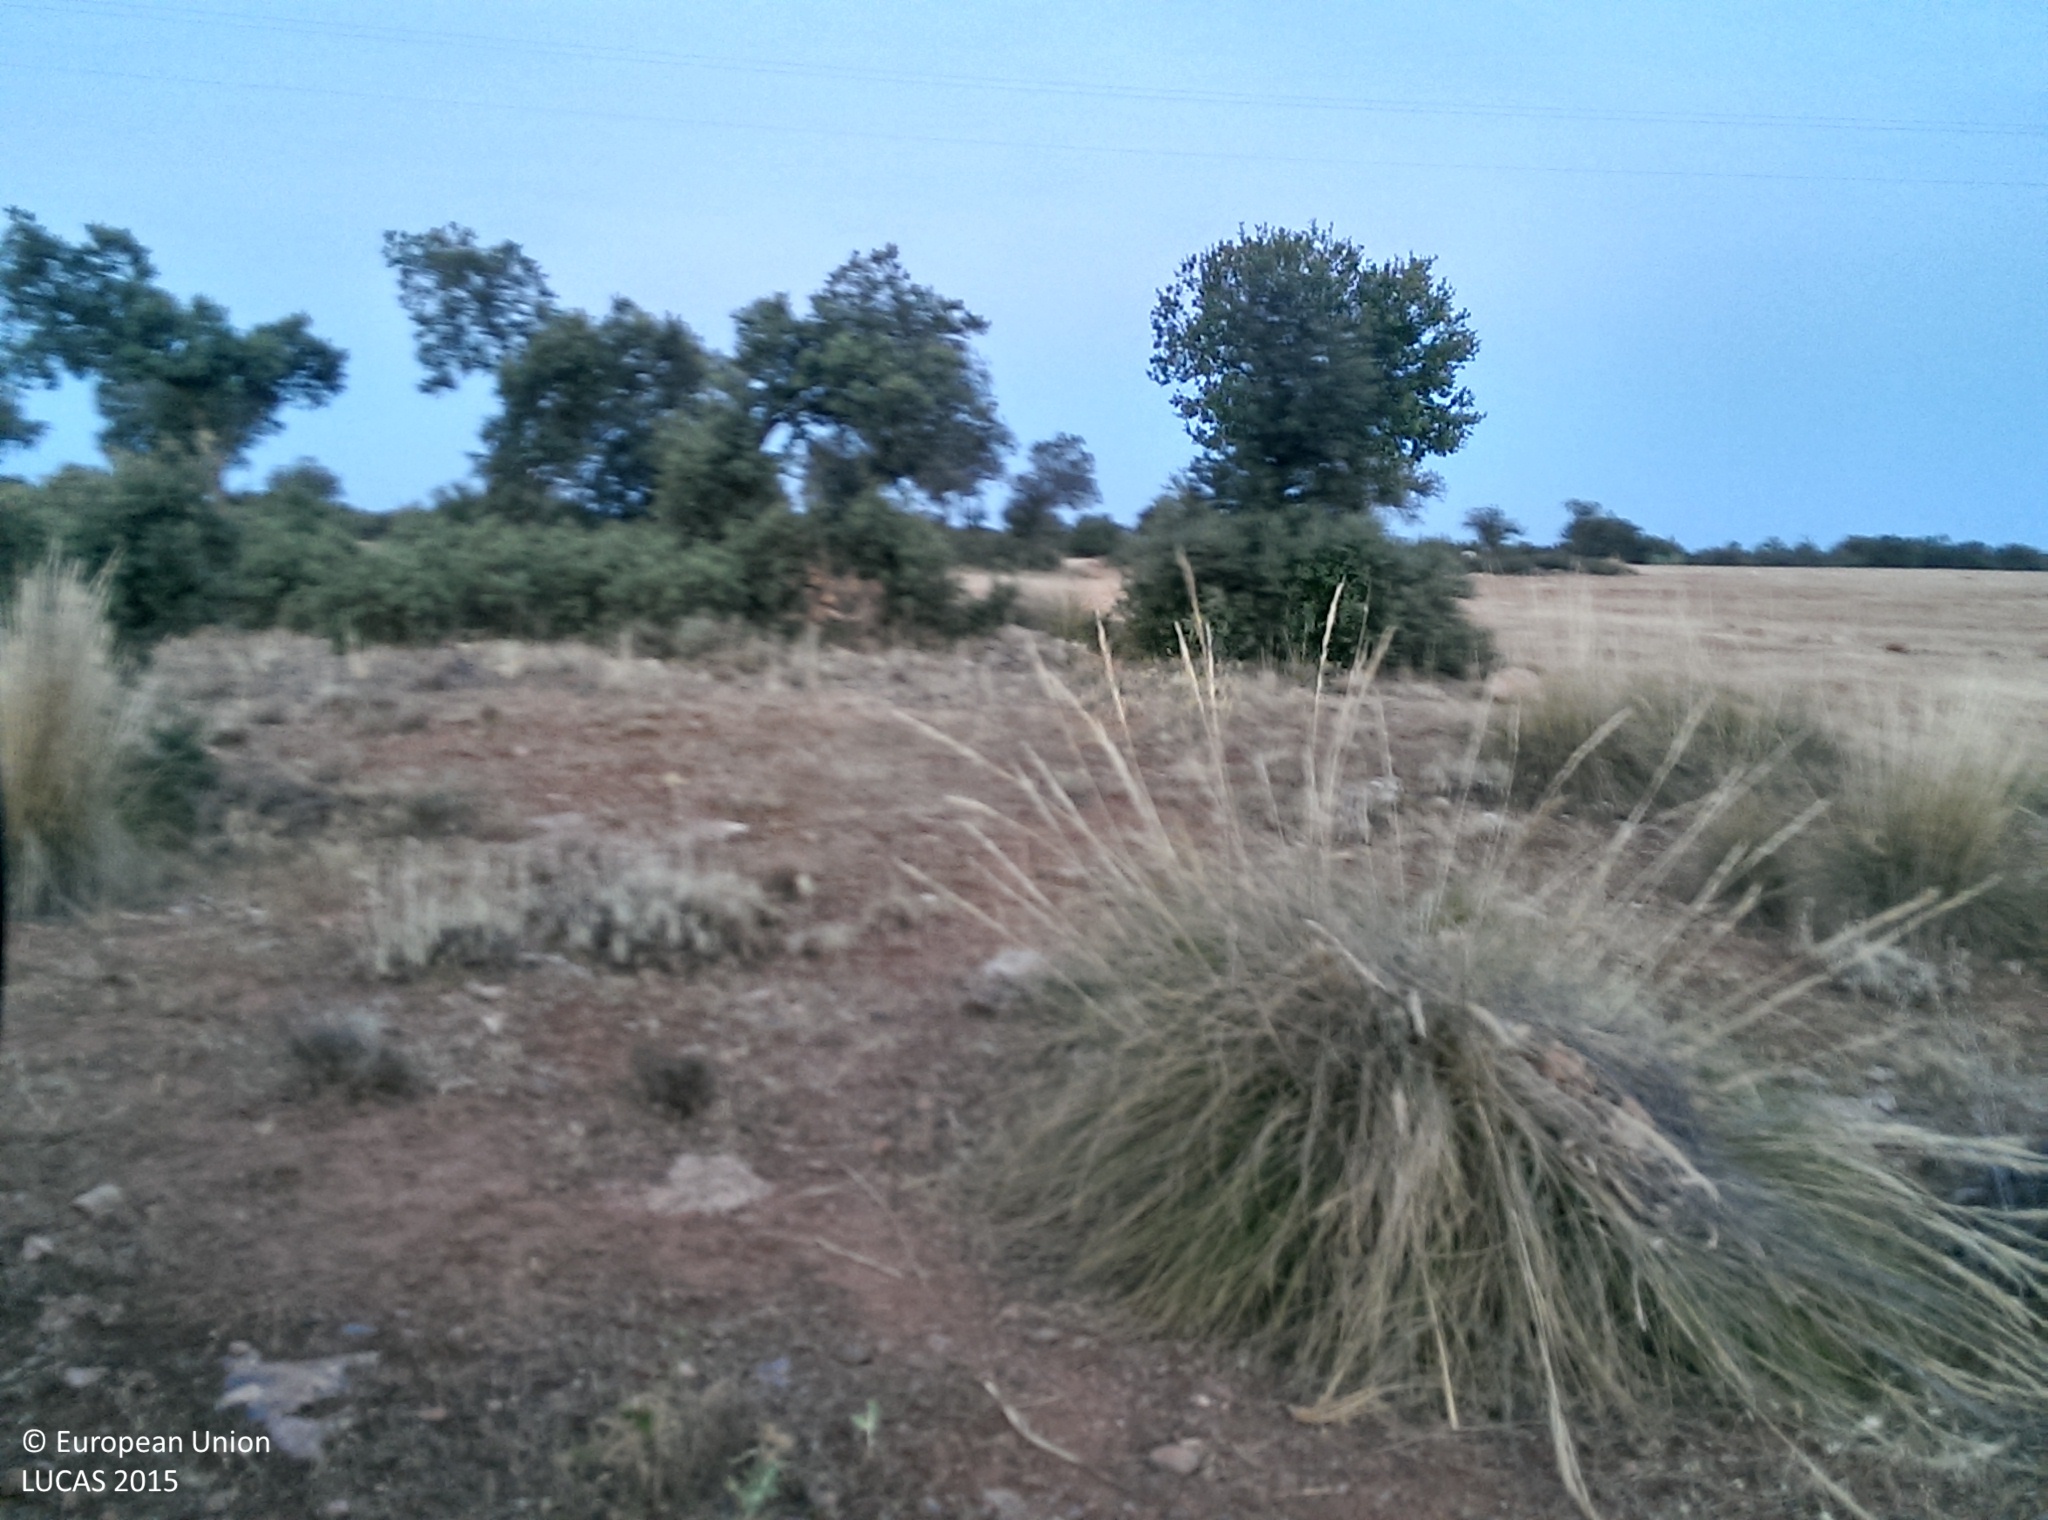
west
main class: Grassland
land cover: Spontaneously vegetated surfaces
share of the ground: 10 - 25 %
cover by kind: unconsolidated bare surface 80 %, herbaceous plants 20 %
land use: Agriculture (excluding fallow land and kitchen gardens)
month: July
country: ES
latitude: 37.4686
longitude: -2.9115
